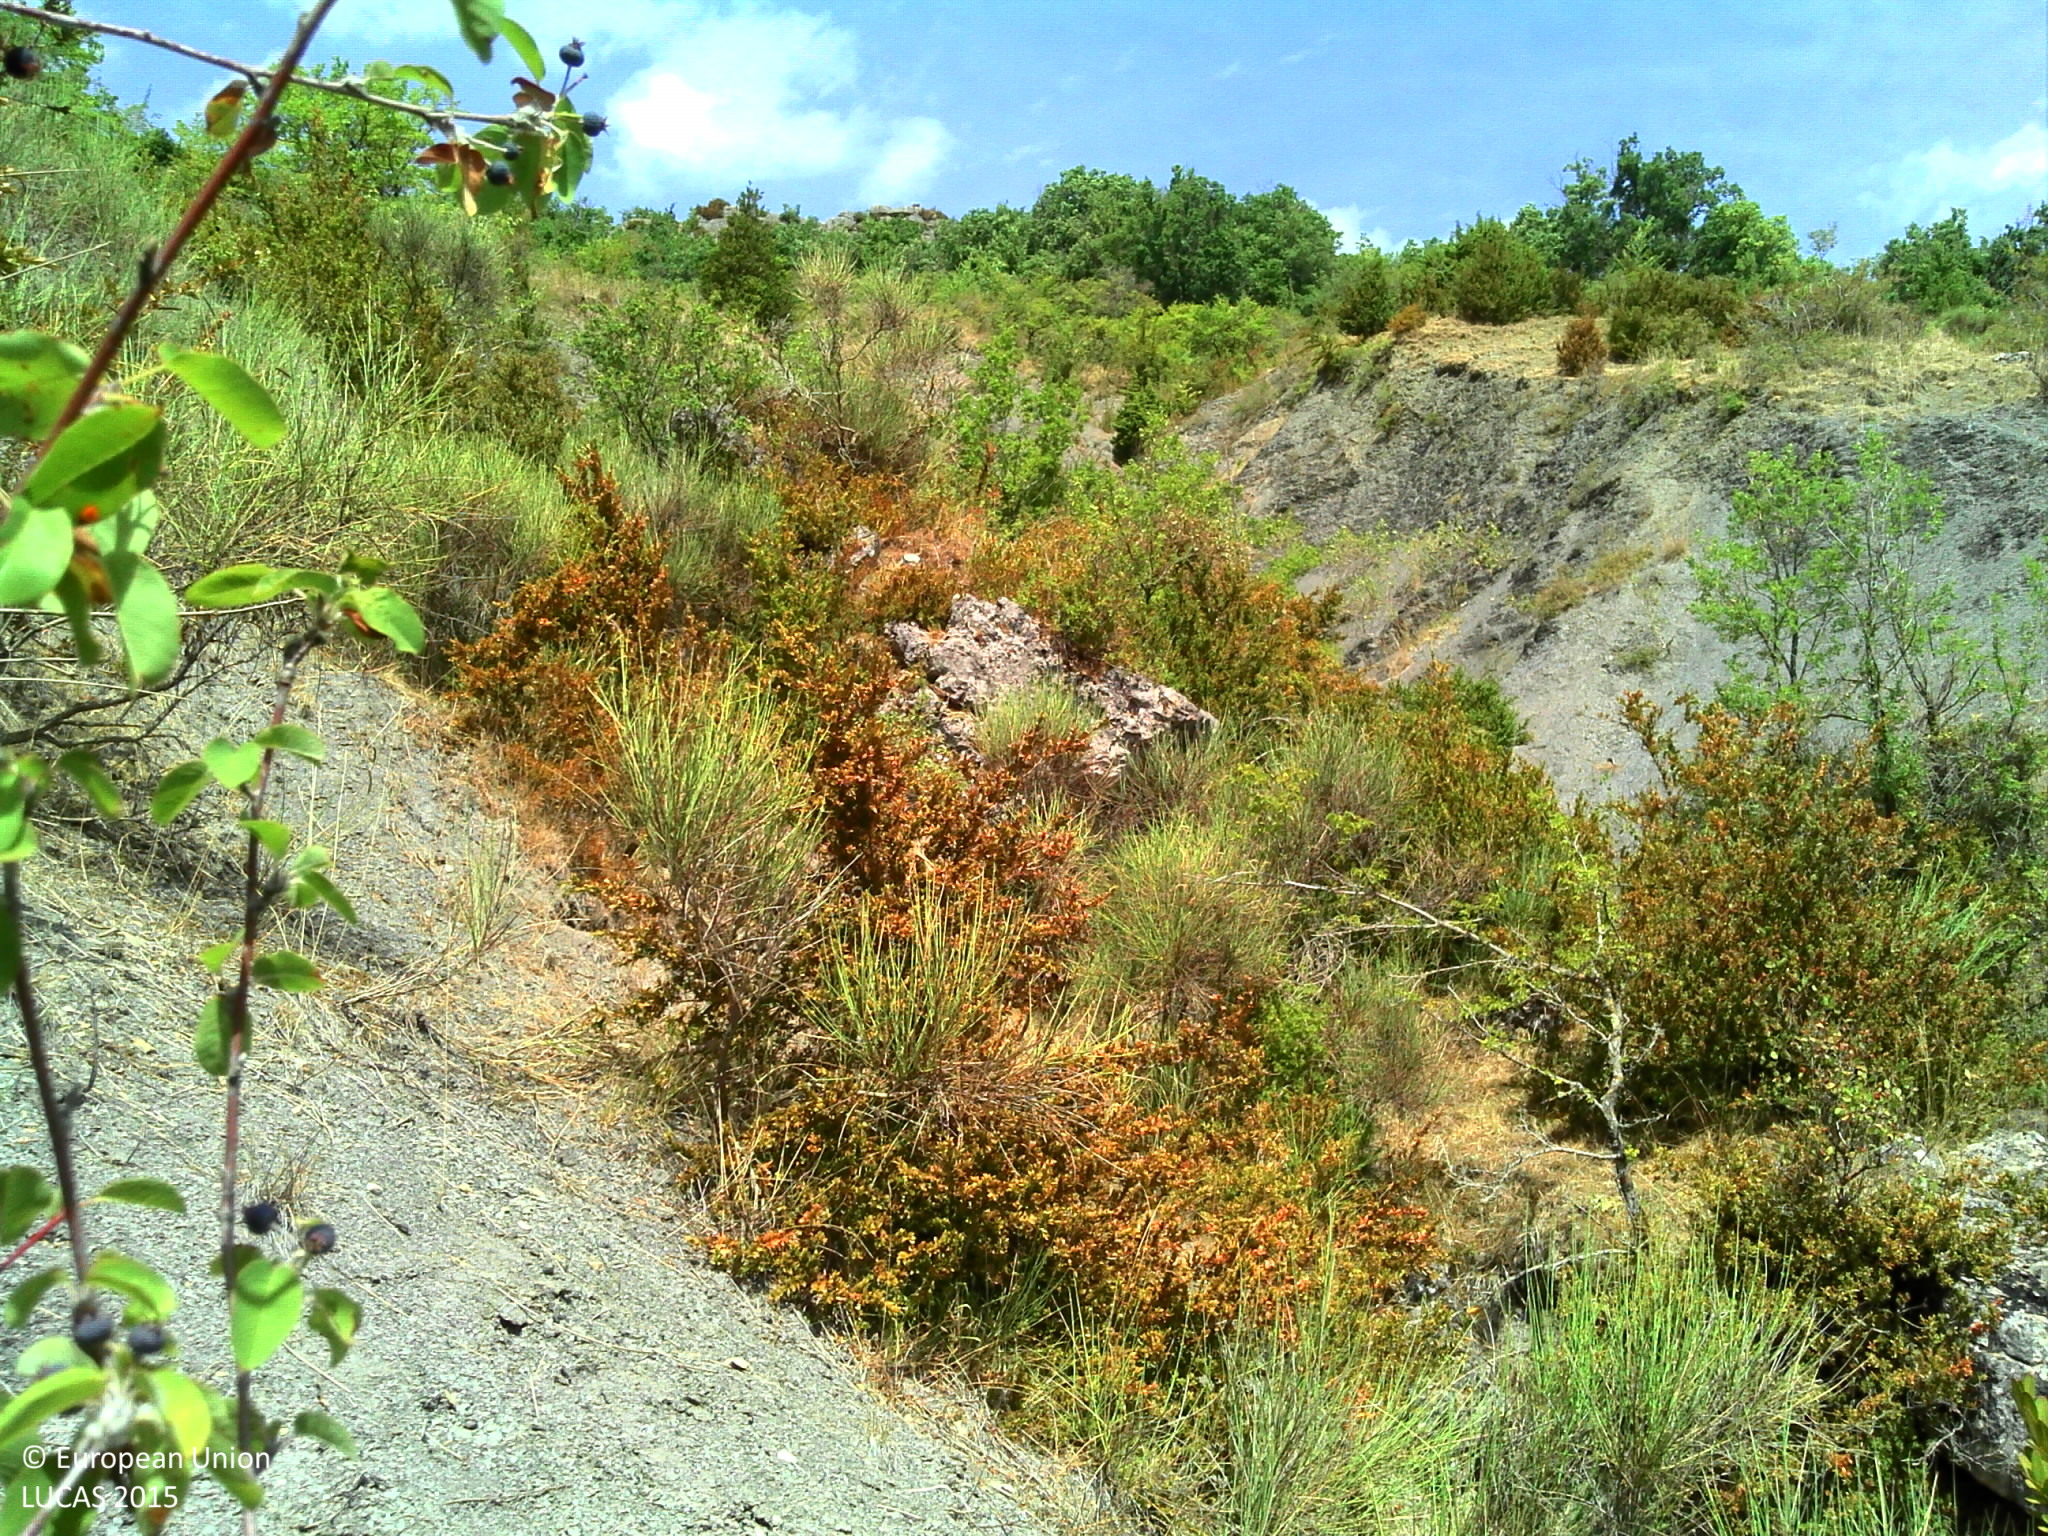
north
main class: Shrubland
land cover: Shrubland without tree cover
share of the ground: > 75 %
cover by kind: shrubs 80 %, unconsolidated bare surface 20 %
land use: Semi-natural and natural areas not in use
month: August
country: FR
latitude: 43.8365
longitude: 3.1794
